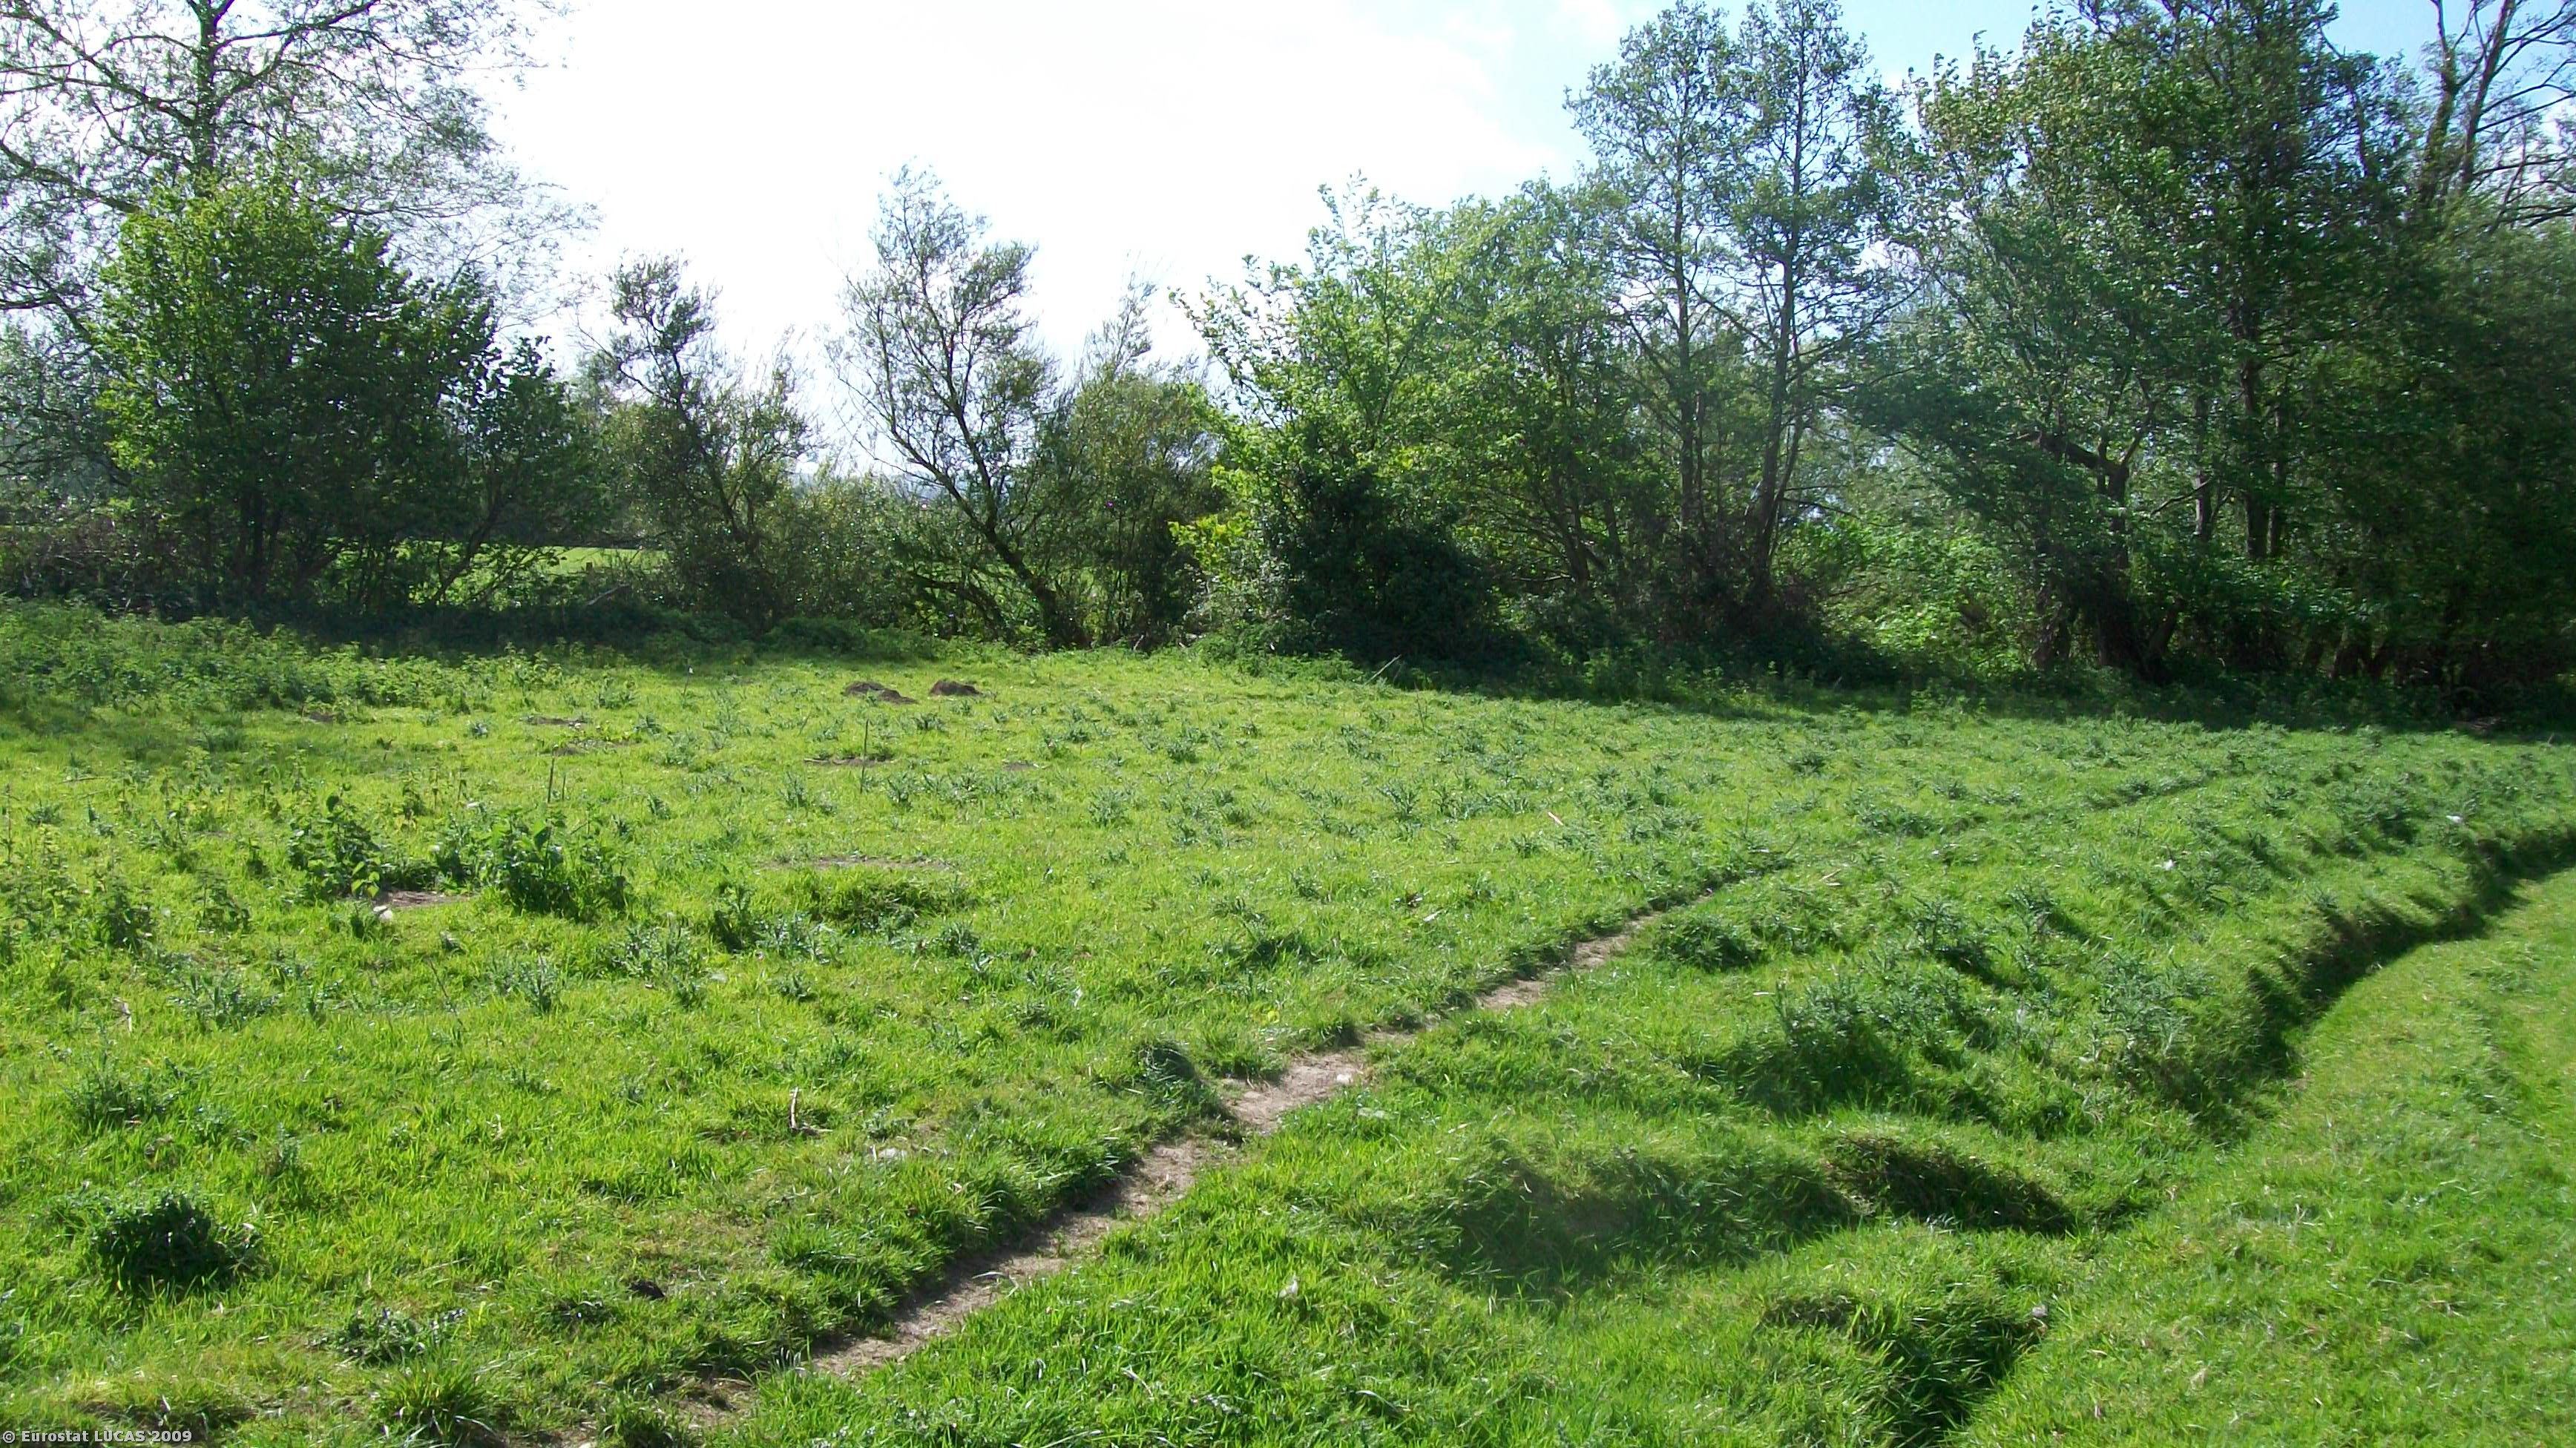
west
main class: Grassland
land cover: Grassland without tree/shrub cover
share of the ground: > 75 %
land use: Agriculture (excluding fallow land and kitchen gardens)
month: May
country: GB
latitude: 53.1690
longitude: -3.3498
